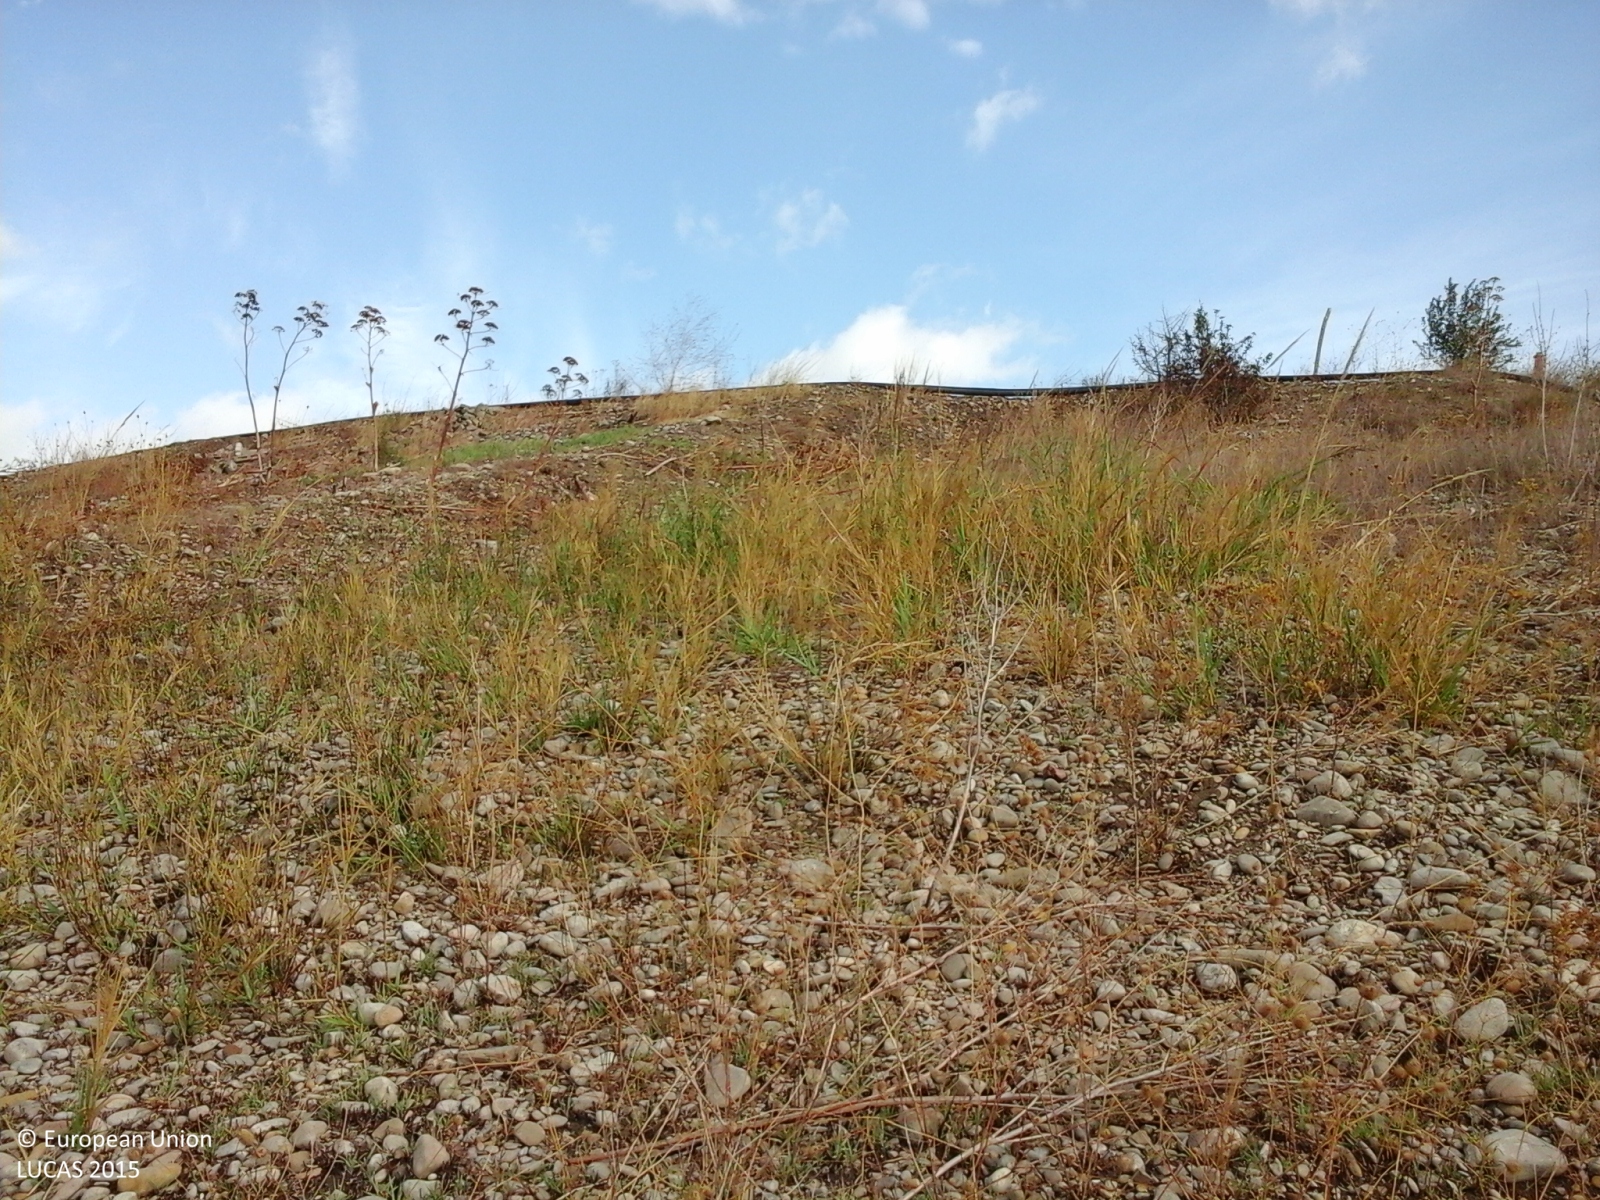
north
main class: Grassland
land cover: Grassland without tree/shrub cover
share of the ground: 50 - 75 %
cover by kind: herbaceous plants 60 %, consolidated bare surface 40 %
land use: Semi-natural and natural areas not in use
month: September
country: IT
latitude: 41.7259
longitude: 15.1647
